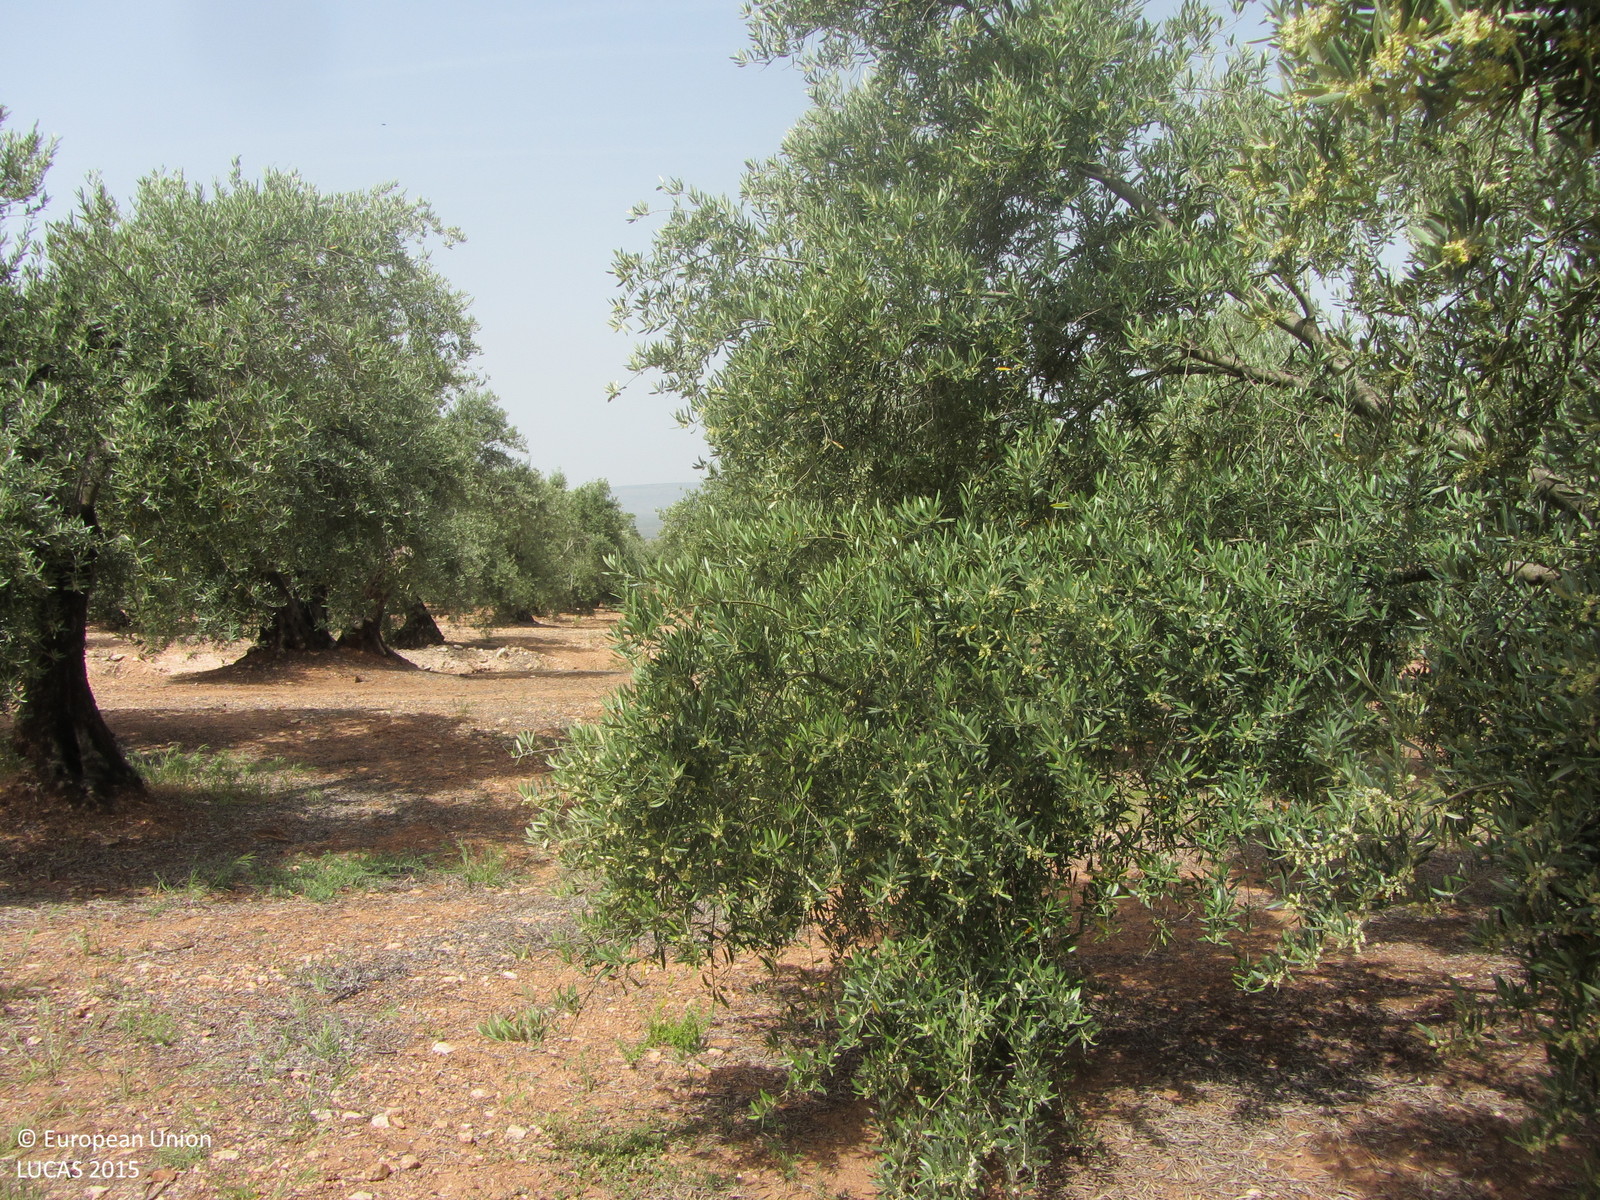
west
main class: Cropland
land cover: Olive groves
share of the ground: 50 - 75 %
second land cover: Spontaneously vegetated surfaces
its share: 10 - 25 %
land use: Agriculture (excluding fallow land and kitchen gardens)
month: May
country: ES
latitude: 38.2937
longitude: -2.9085
